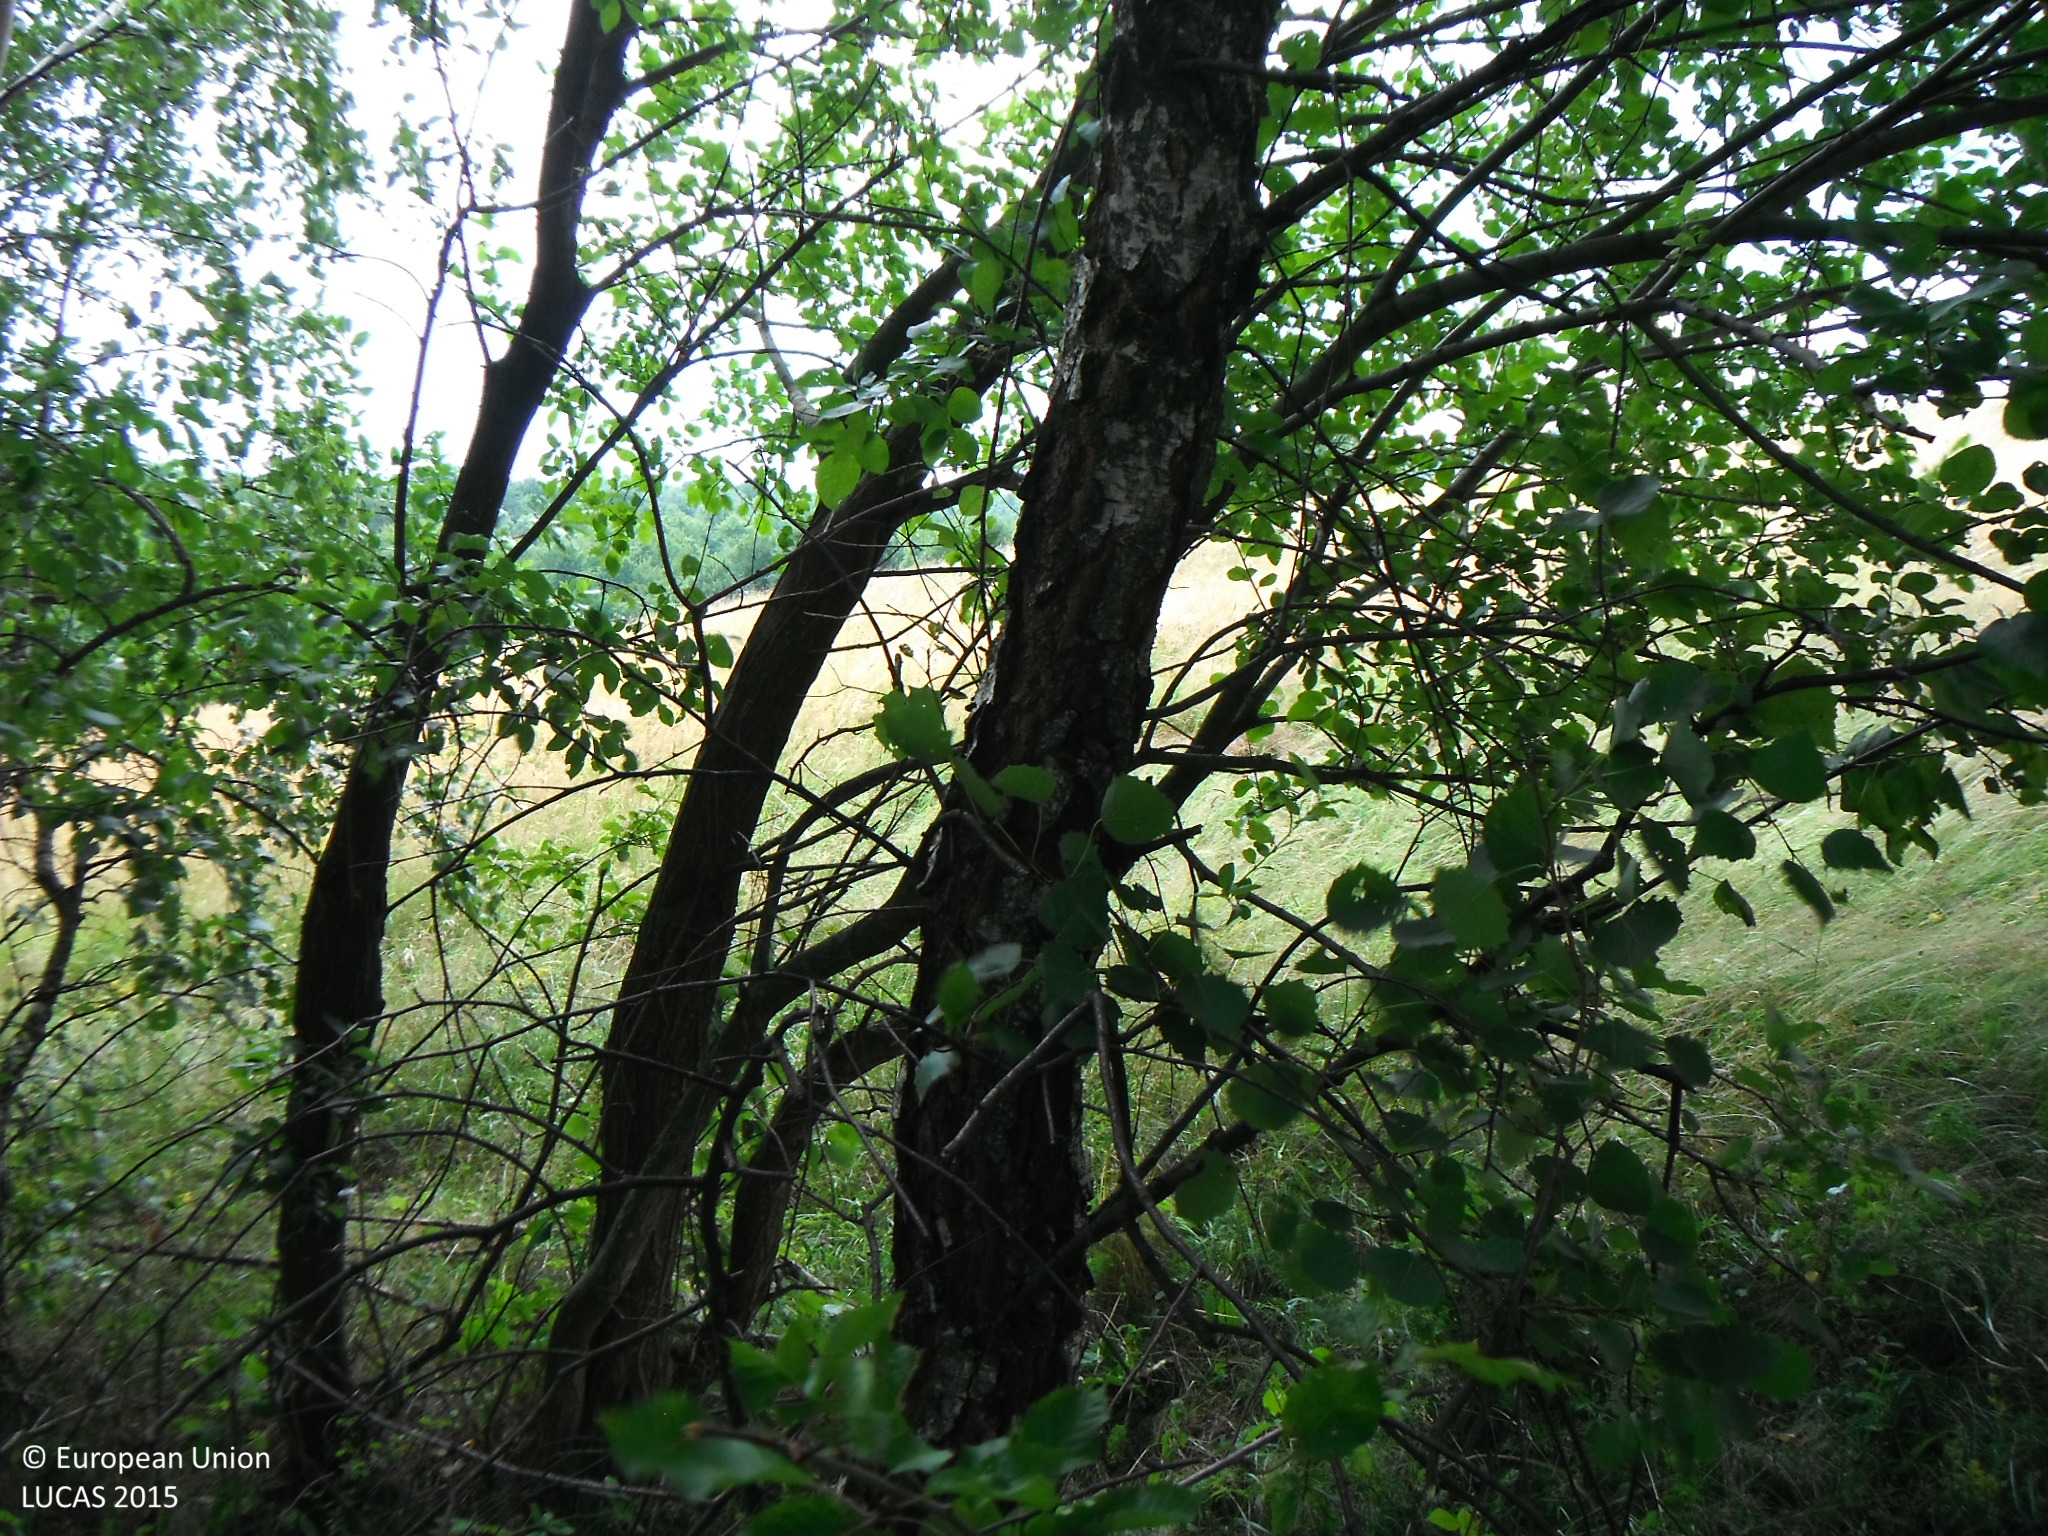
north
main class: Woodland
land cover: Broadleaved woodland
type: beech forest
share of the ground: > 75 %
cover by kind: broadleaved forest trees 100 %
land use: Forestry
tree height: > 5 m
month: July
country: SK
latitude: 49.3273
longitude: 21.6783
